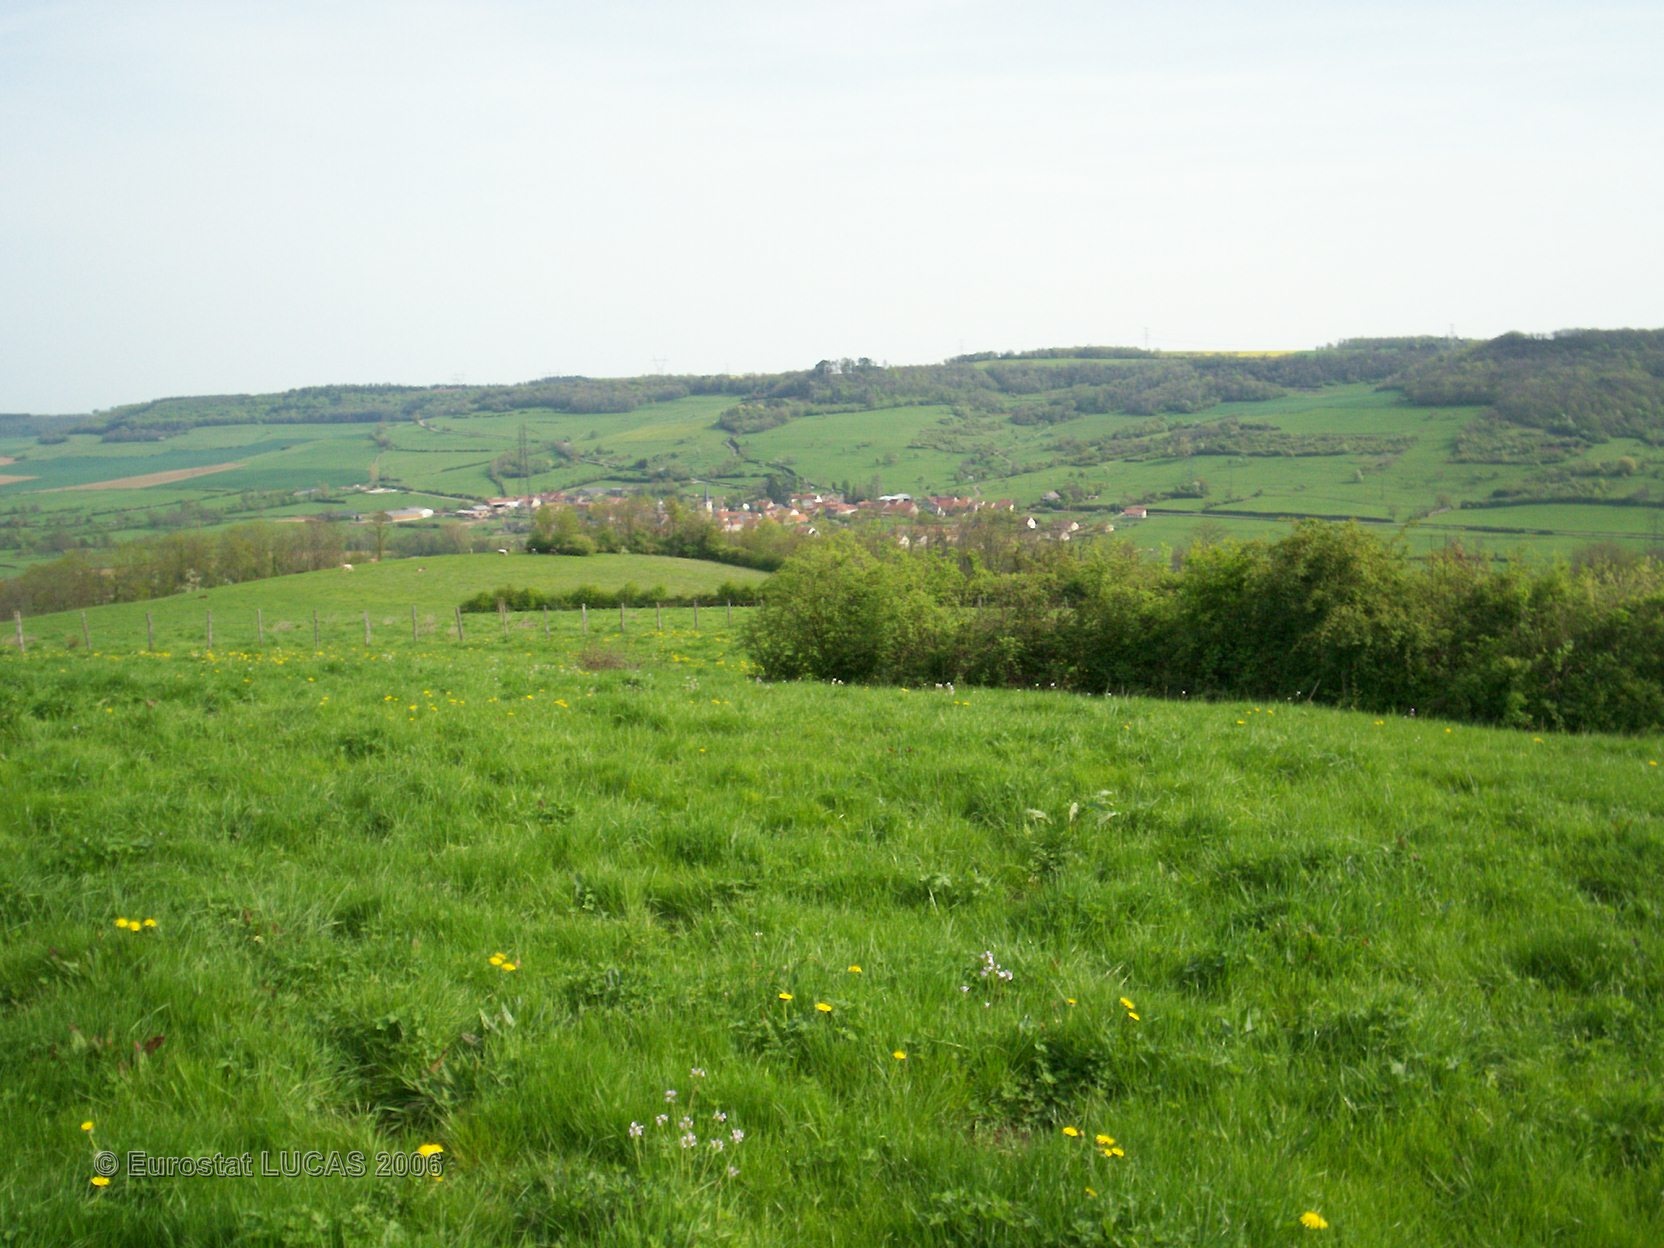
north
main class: Grassland
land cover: Grassland without tree/shrub cover
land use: Agriculture (excluding fallow land and kitchen gardens)
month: May
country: FR
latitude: 47.4074
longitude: 4.6325
